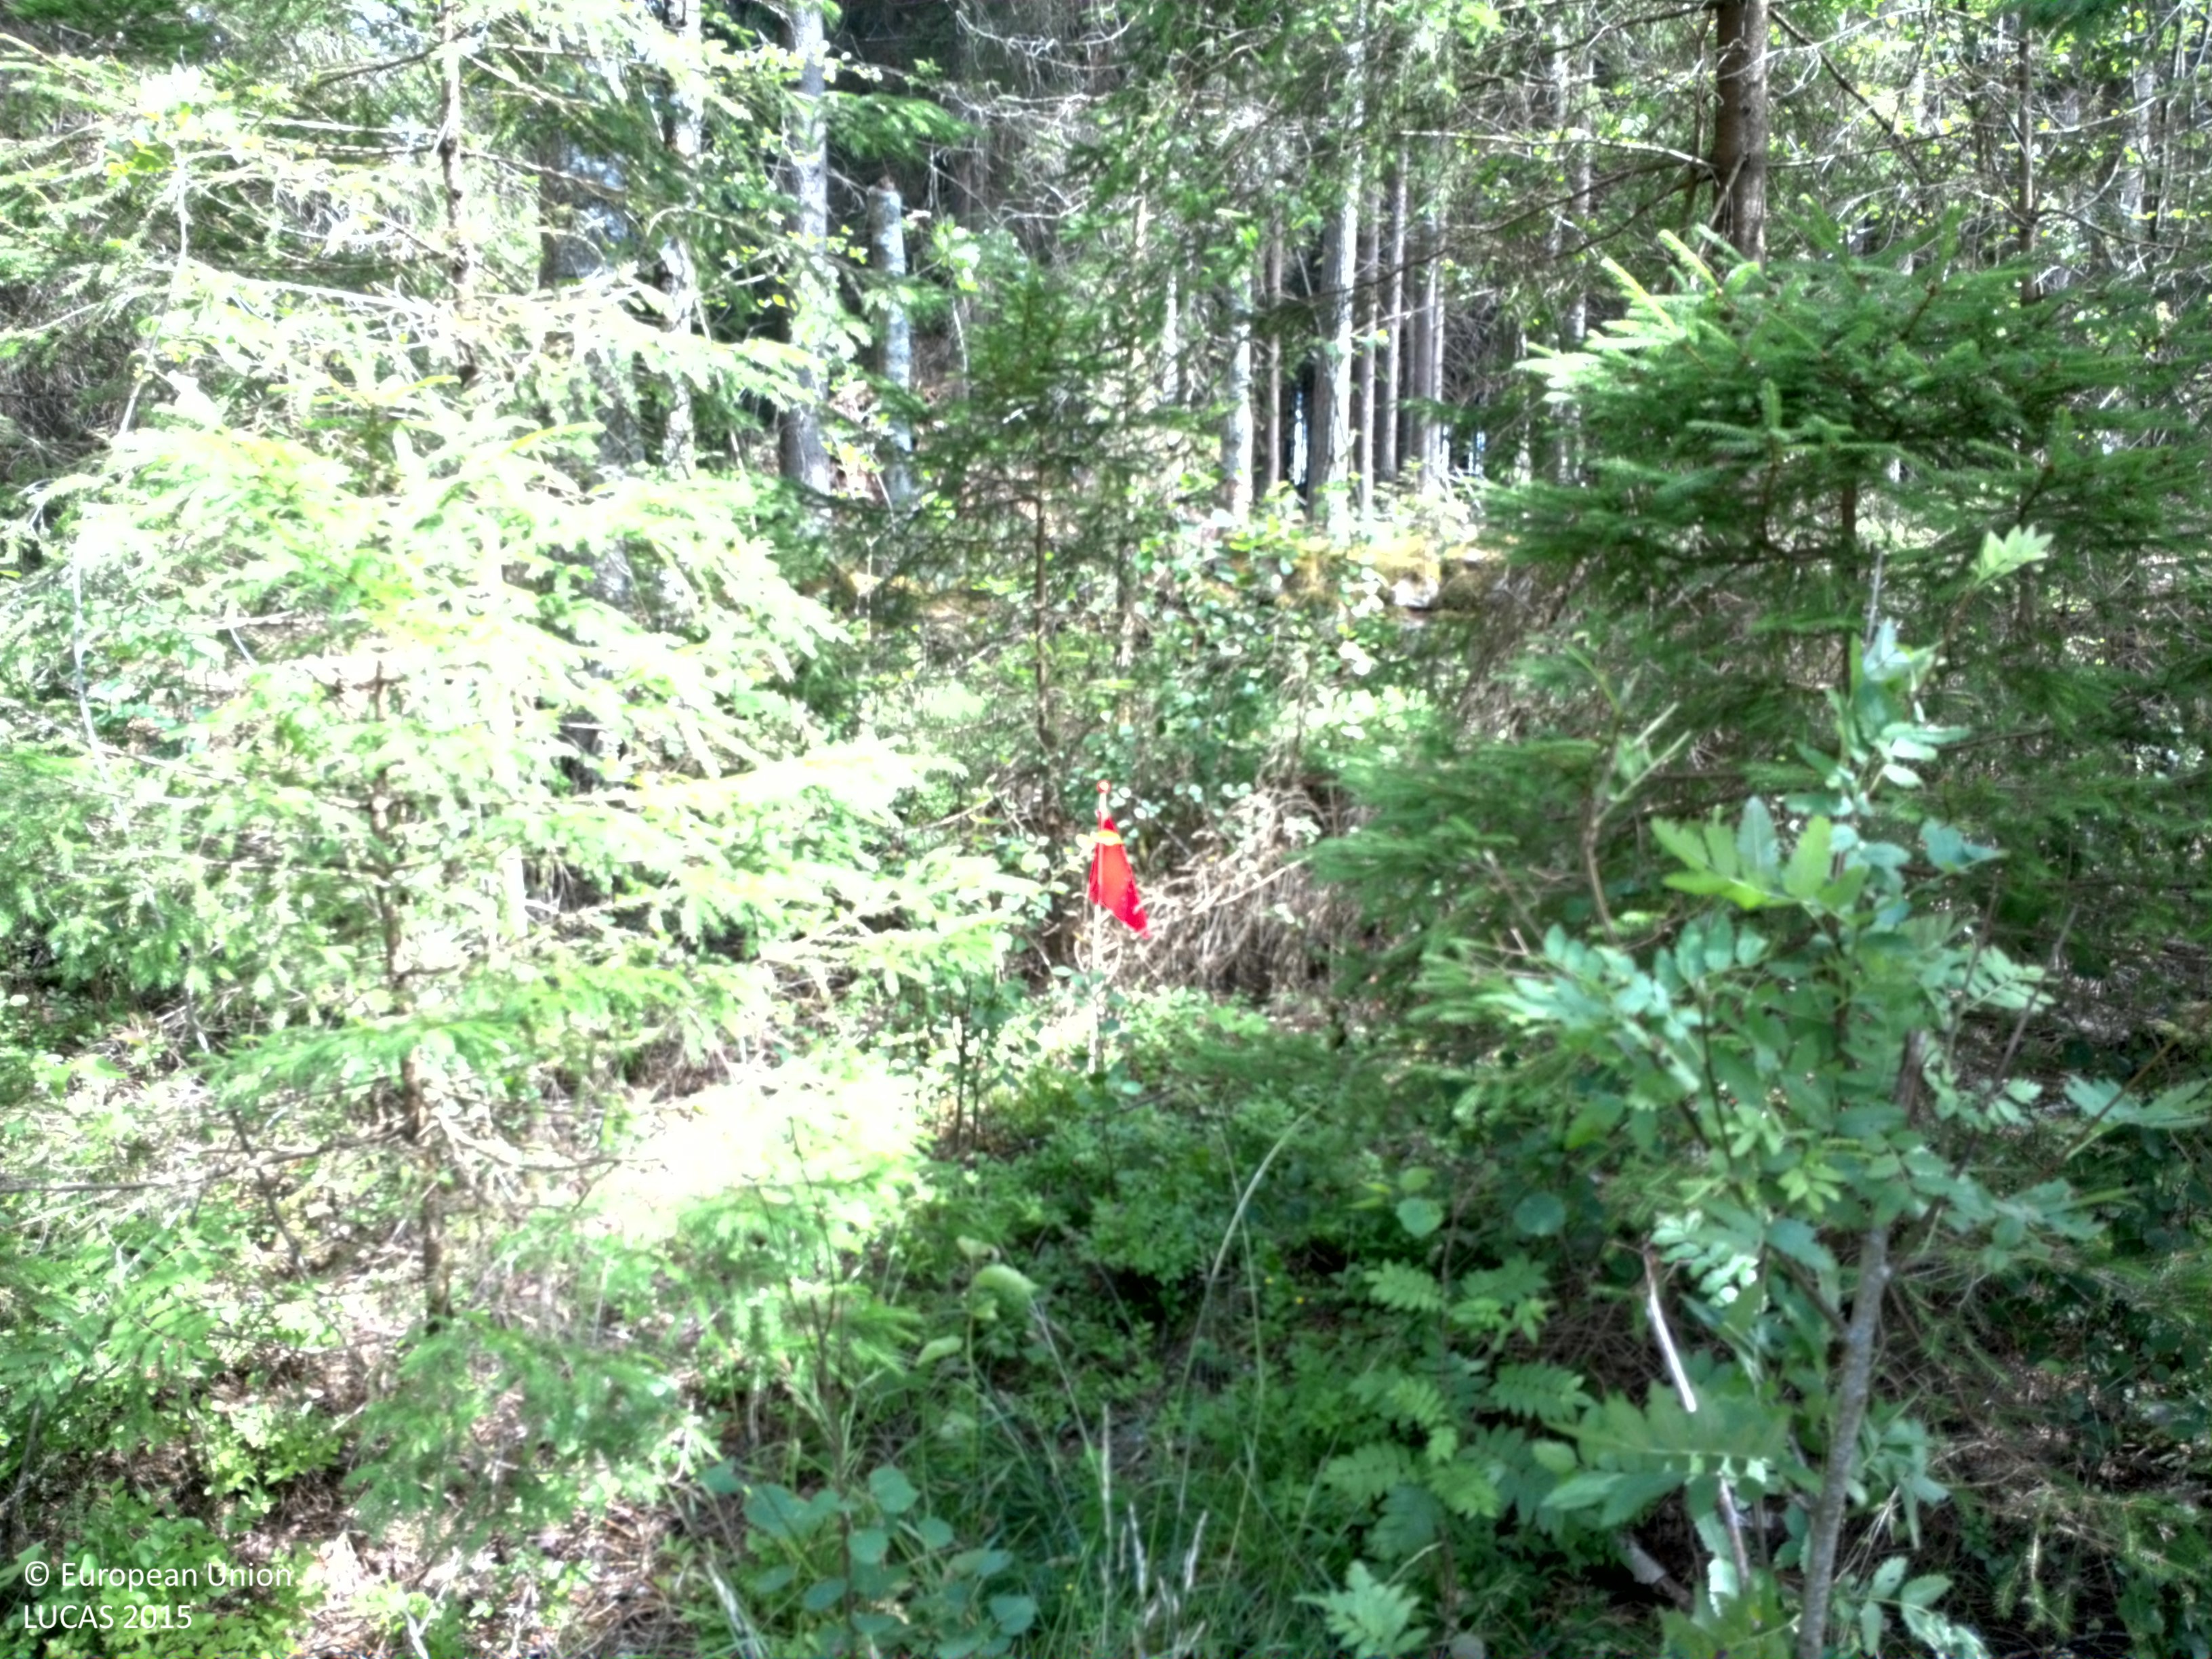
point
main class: Woodland
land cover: Spruce dominated mixed woodland
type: boreal forest
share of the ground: 50 - 75 %
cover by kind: broadleaved forest trees 35 %, coniferous forest trees 30 %, shrubs 15 %, herbaceous plants 10 %, lichens and mosses 10 %
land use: Forestry
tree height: > 5 m
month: July
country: SE
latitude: 58.1813
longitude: 13.8885
